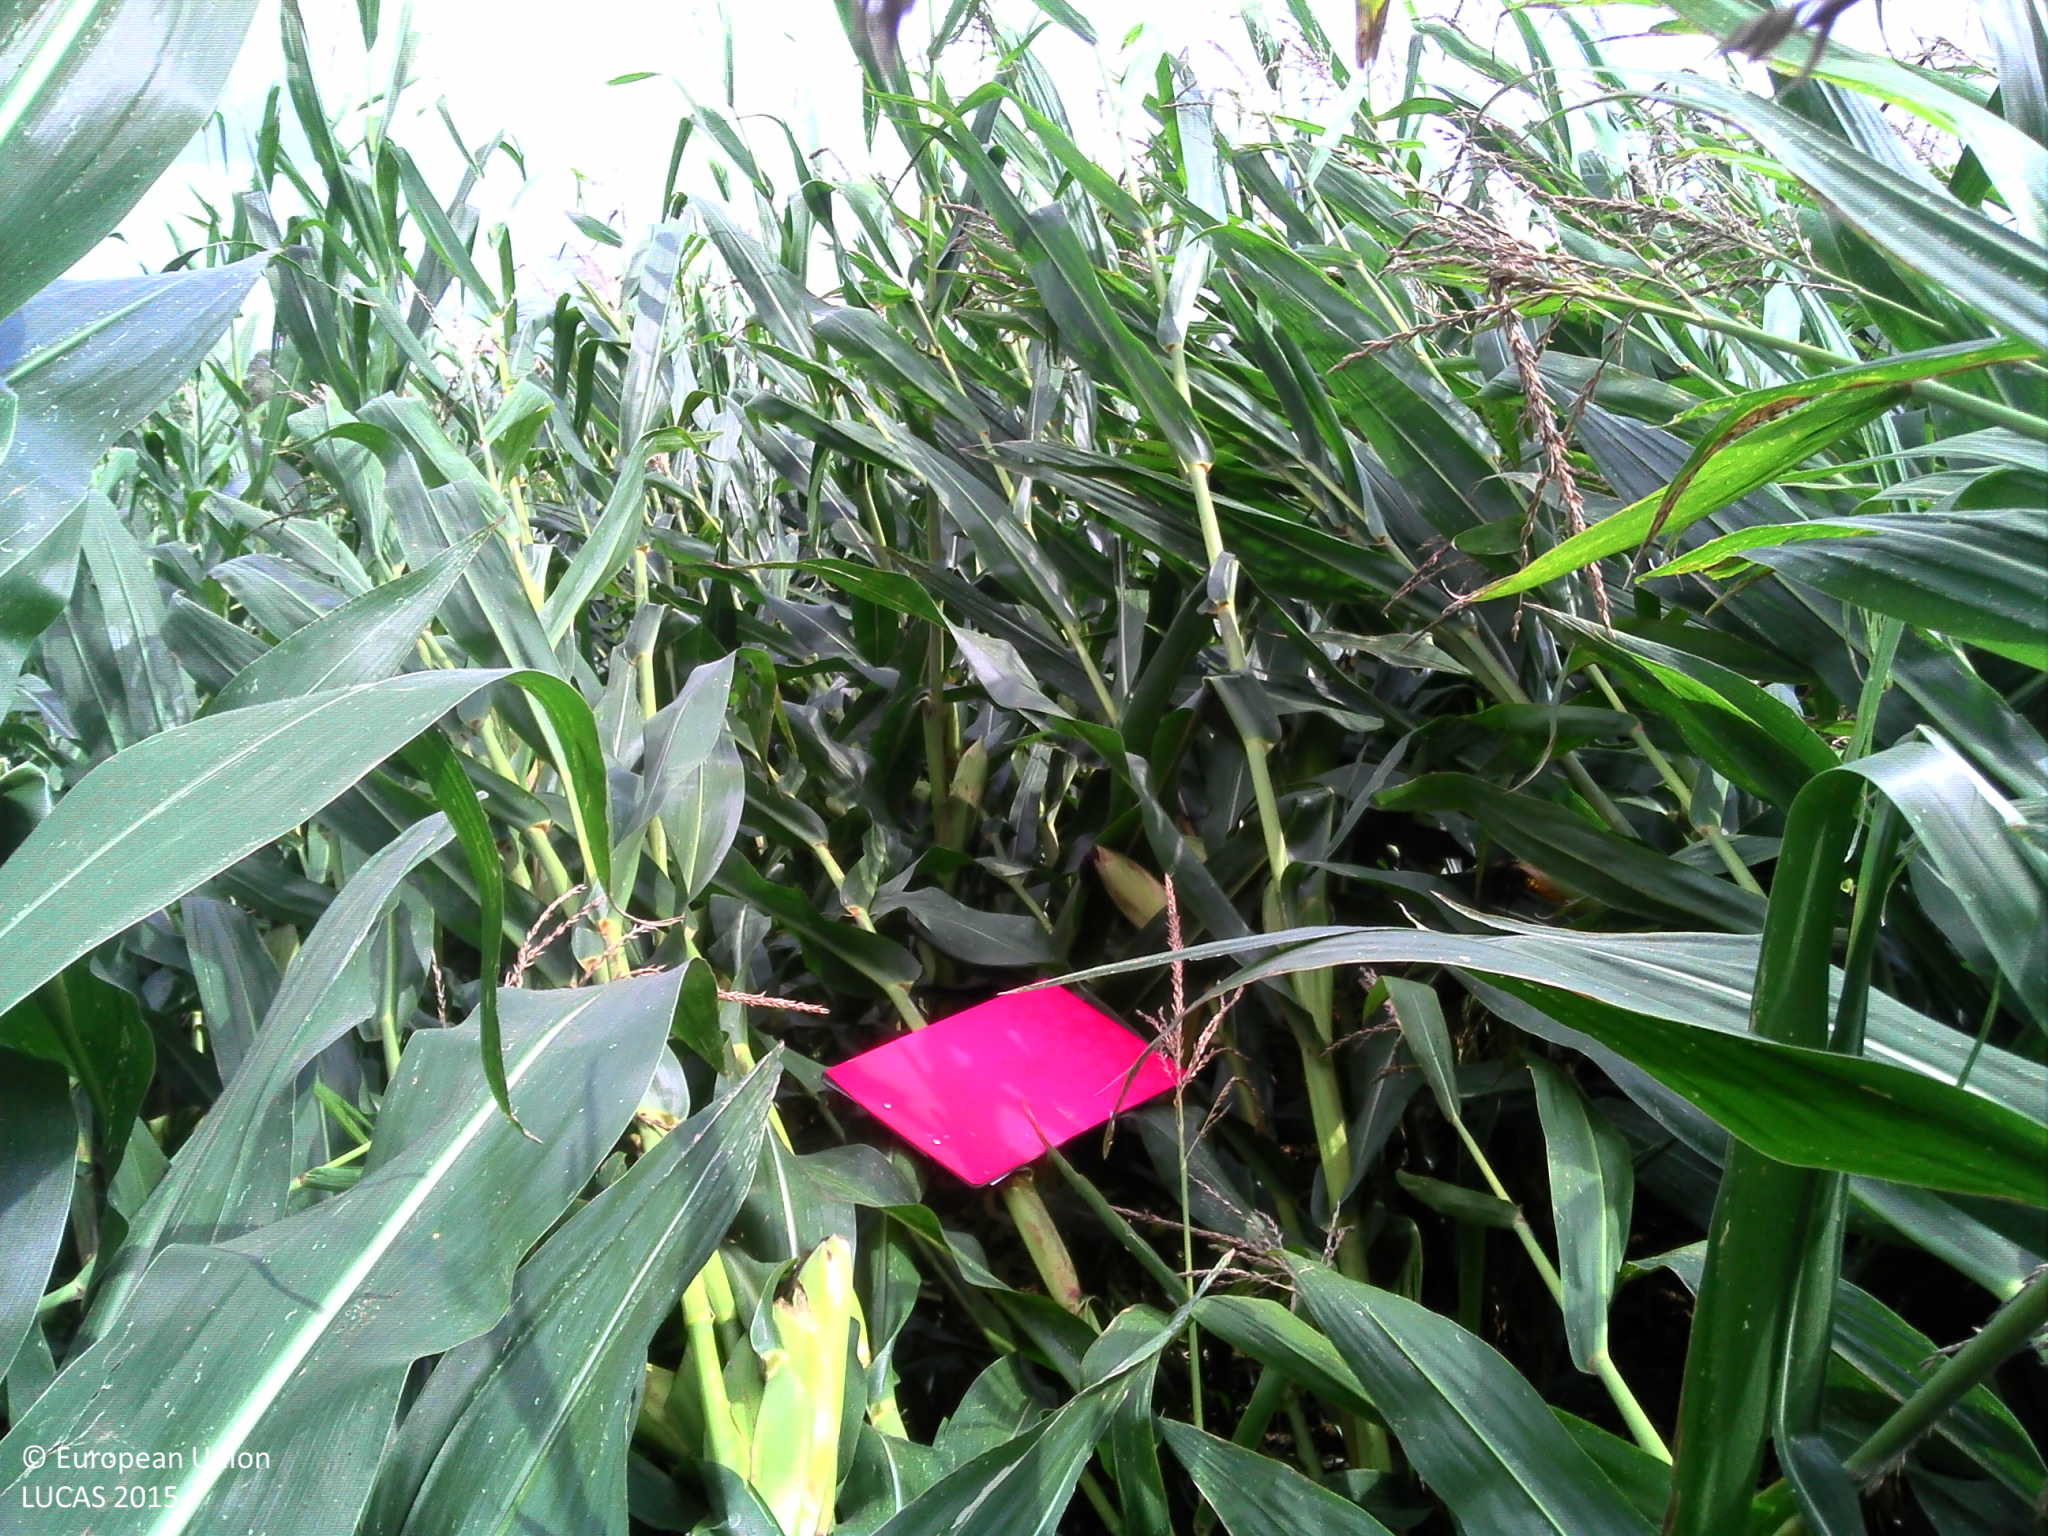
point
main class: Cropland
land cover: Maize
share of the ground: > 75 %
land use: Agriculture (excluding fallow land and kitchen gardens)
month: September
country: FR
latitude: 43.5138
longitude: -0.4370
